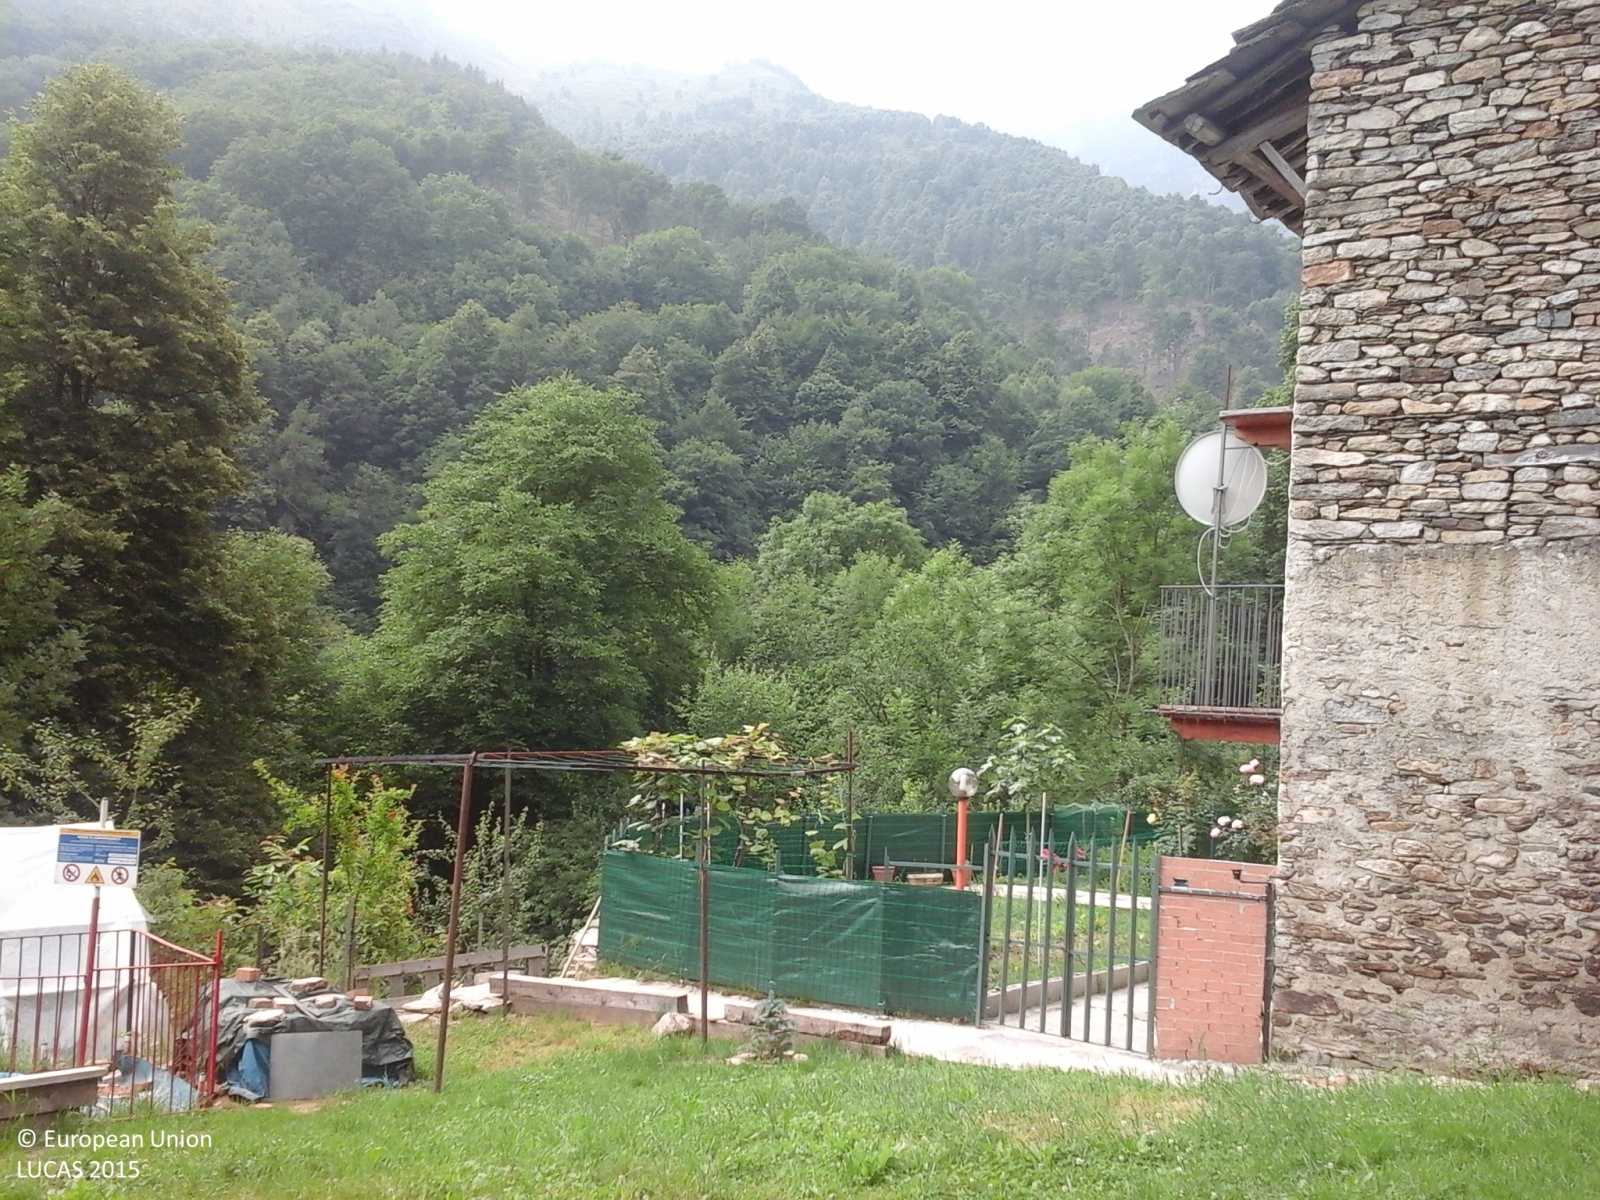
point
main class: Woodland
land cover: Broadleaved woodland
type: mesophytic deciduous forest
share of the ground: > 75 %
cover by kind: broadleaved forest trees 100 %
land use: Forestry
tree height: > 5 m
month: July
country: IT
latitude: 45.0358
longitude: 7.2501
